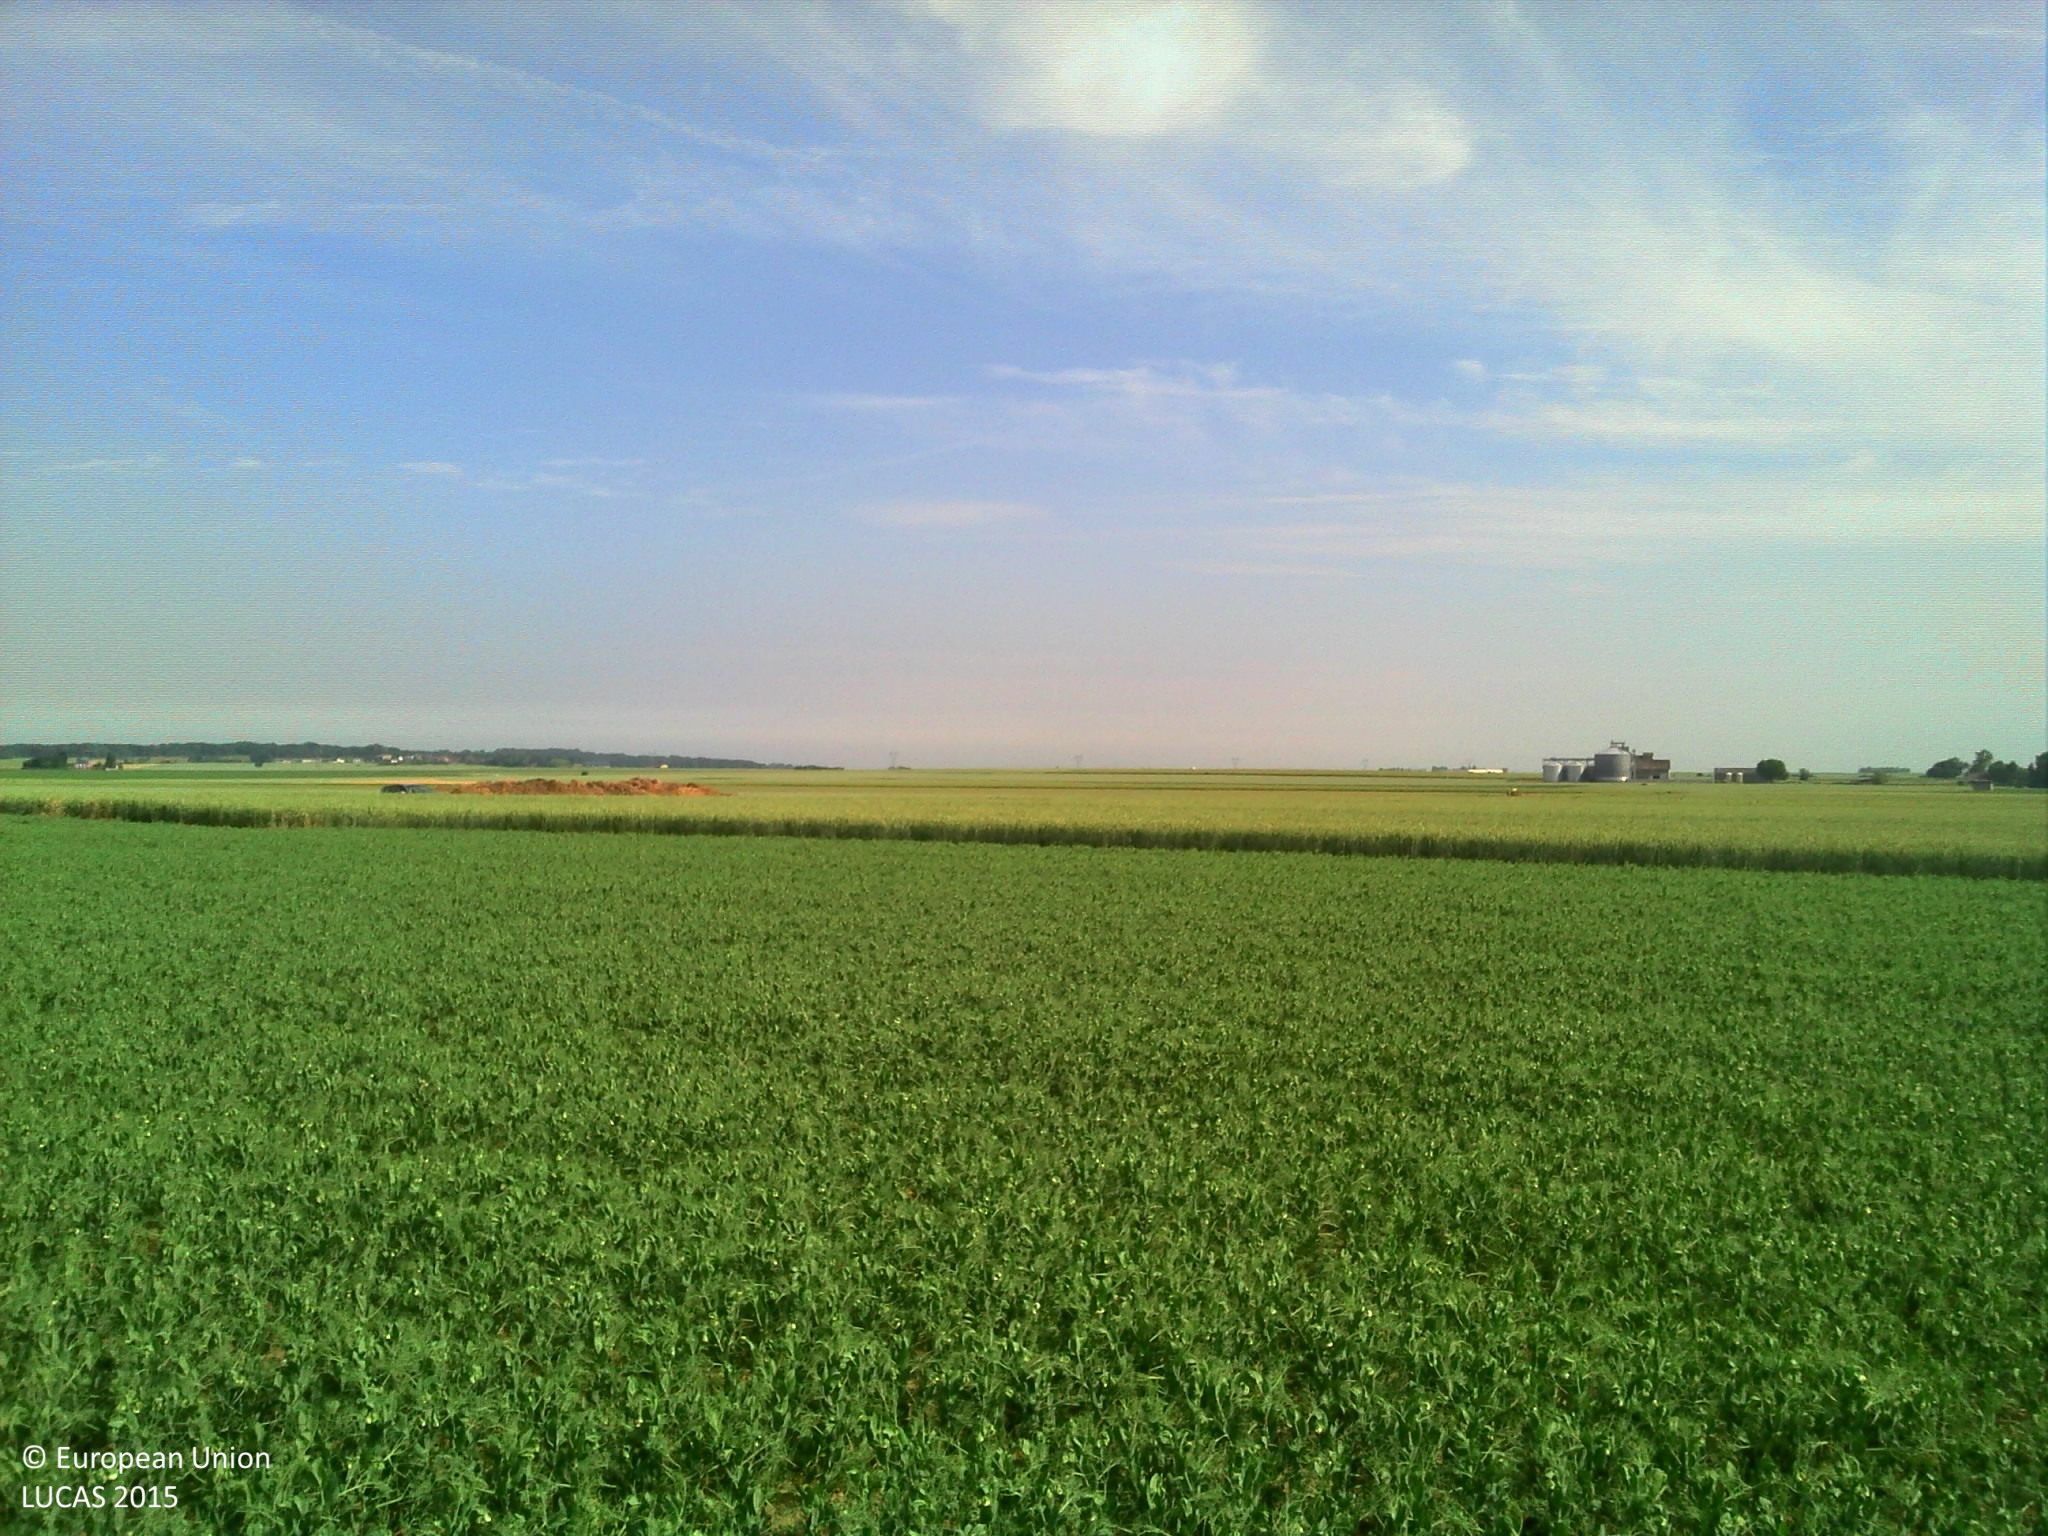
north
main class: Cropland
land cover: Dry pulses
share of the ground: > 75 %
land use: Agriculture (excluding fallow land and kitchen gardens)
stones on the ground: < 10 %
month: June
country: FR
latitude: 49.5102
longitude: 2.5997
